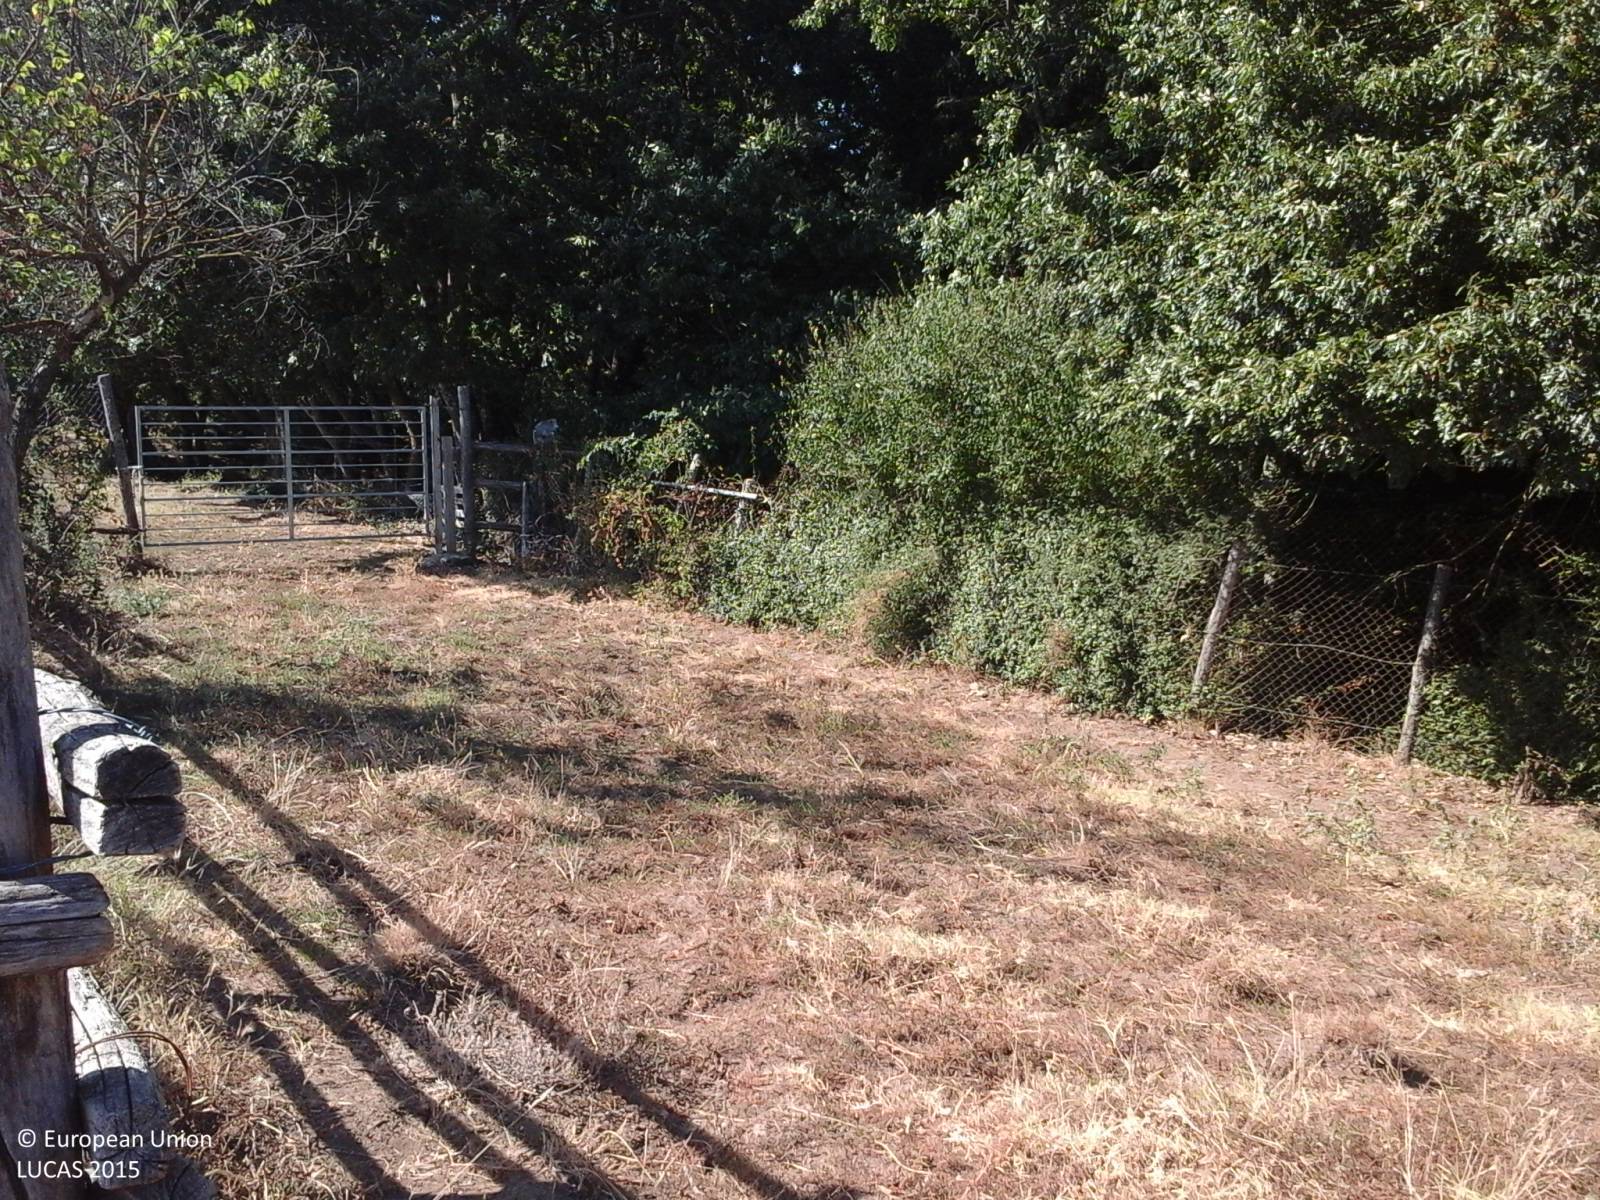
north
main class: Grassland
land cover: Grassland without tree/shrub cover
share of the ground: > 75 %
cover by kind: herbaceous plants 55 %, unconsolidated bare surface 45 %
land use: Agriculture (excluding fallow land and kitchen gardens)
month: July
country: IT
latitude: 42.1889
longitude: 12.5218
